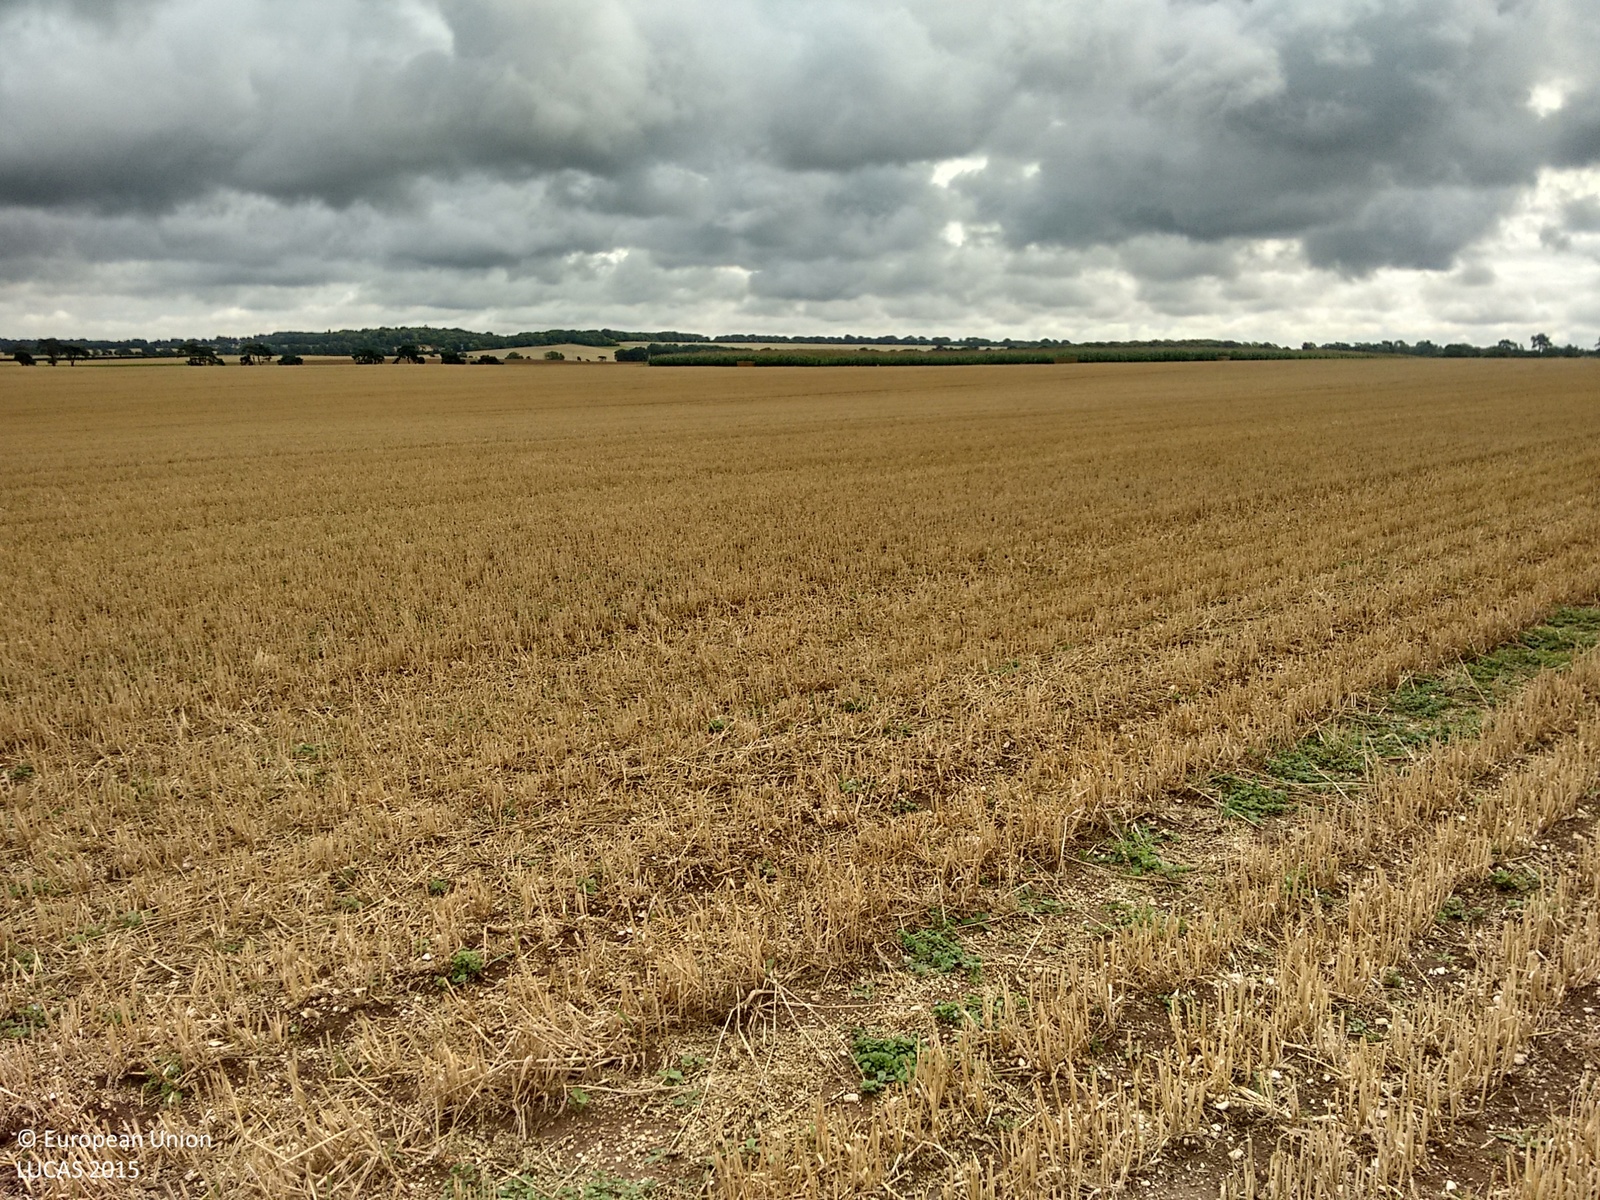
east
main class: Cropland
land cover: Common wheat
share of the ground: > 75 %
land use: Agriculture (excluding fallow land and kitchen gardens)
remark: Harvested field
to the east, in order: Common wheat; Maize; Common wheat
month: August
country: GB
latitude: 52.1789
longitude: 0.3037
